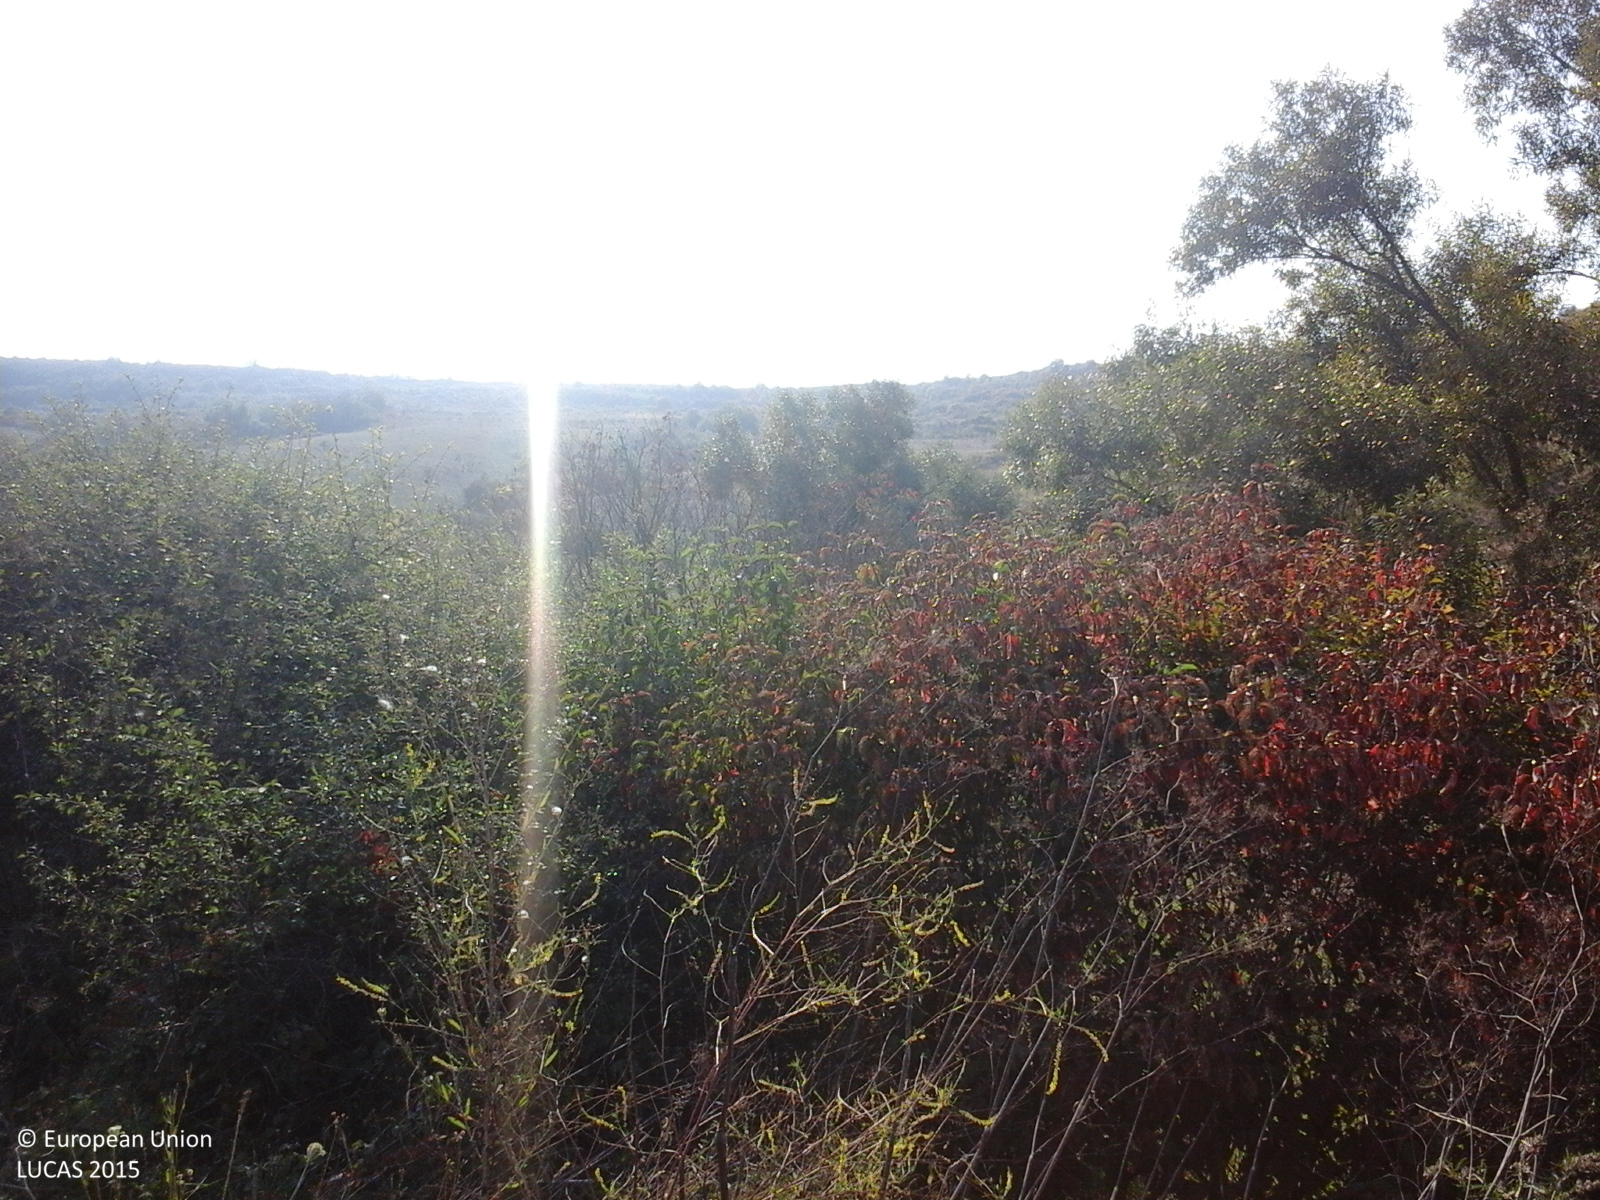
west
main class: Shrubland
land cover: Shrubland without tree cover
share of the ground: > 75 %
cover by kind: shrubs 100 %
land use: Fallow land
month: September
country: RO
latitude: 47.0040
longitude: 23.3652
